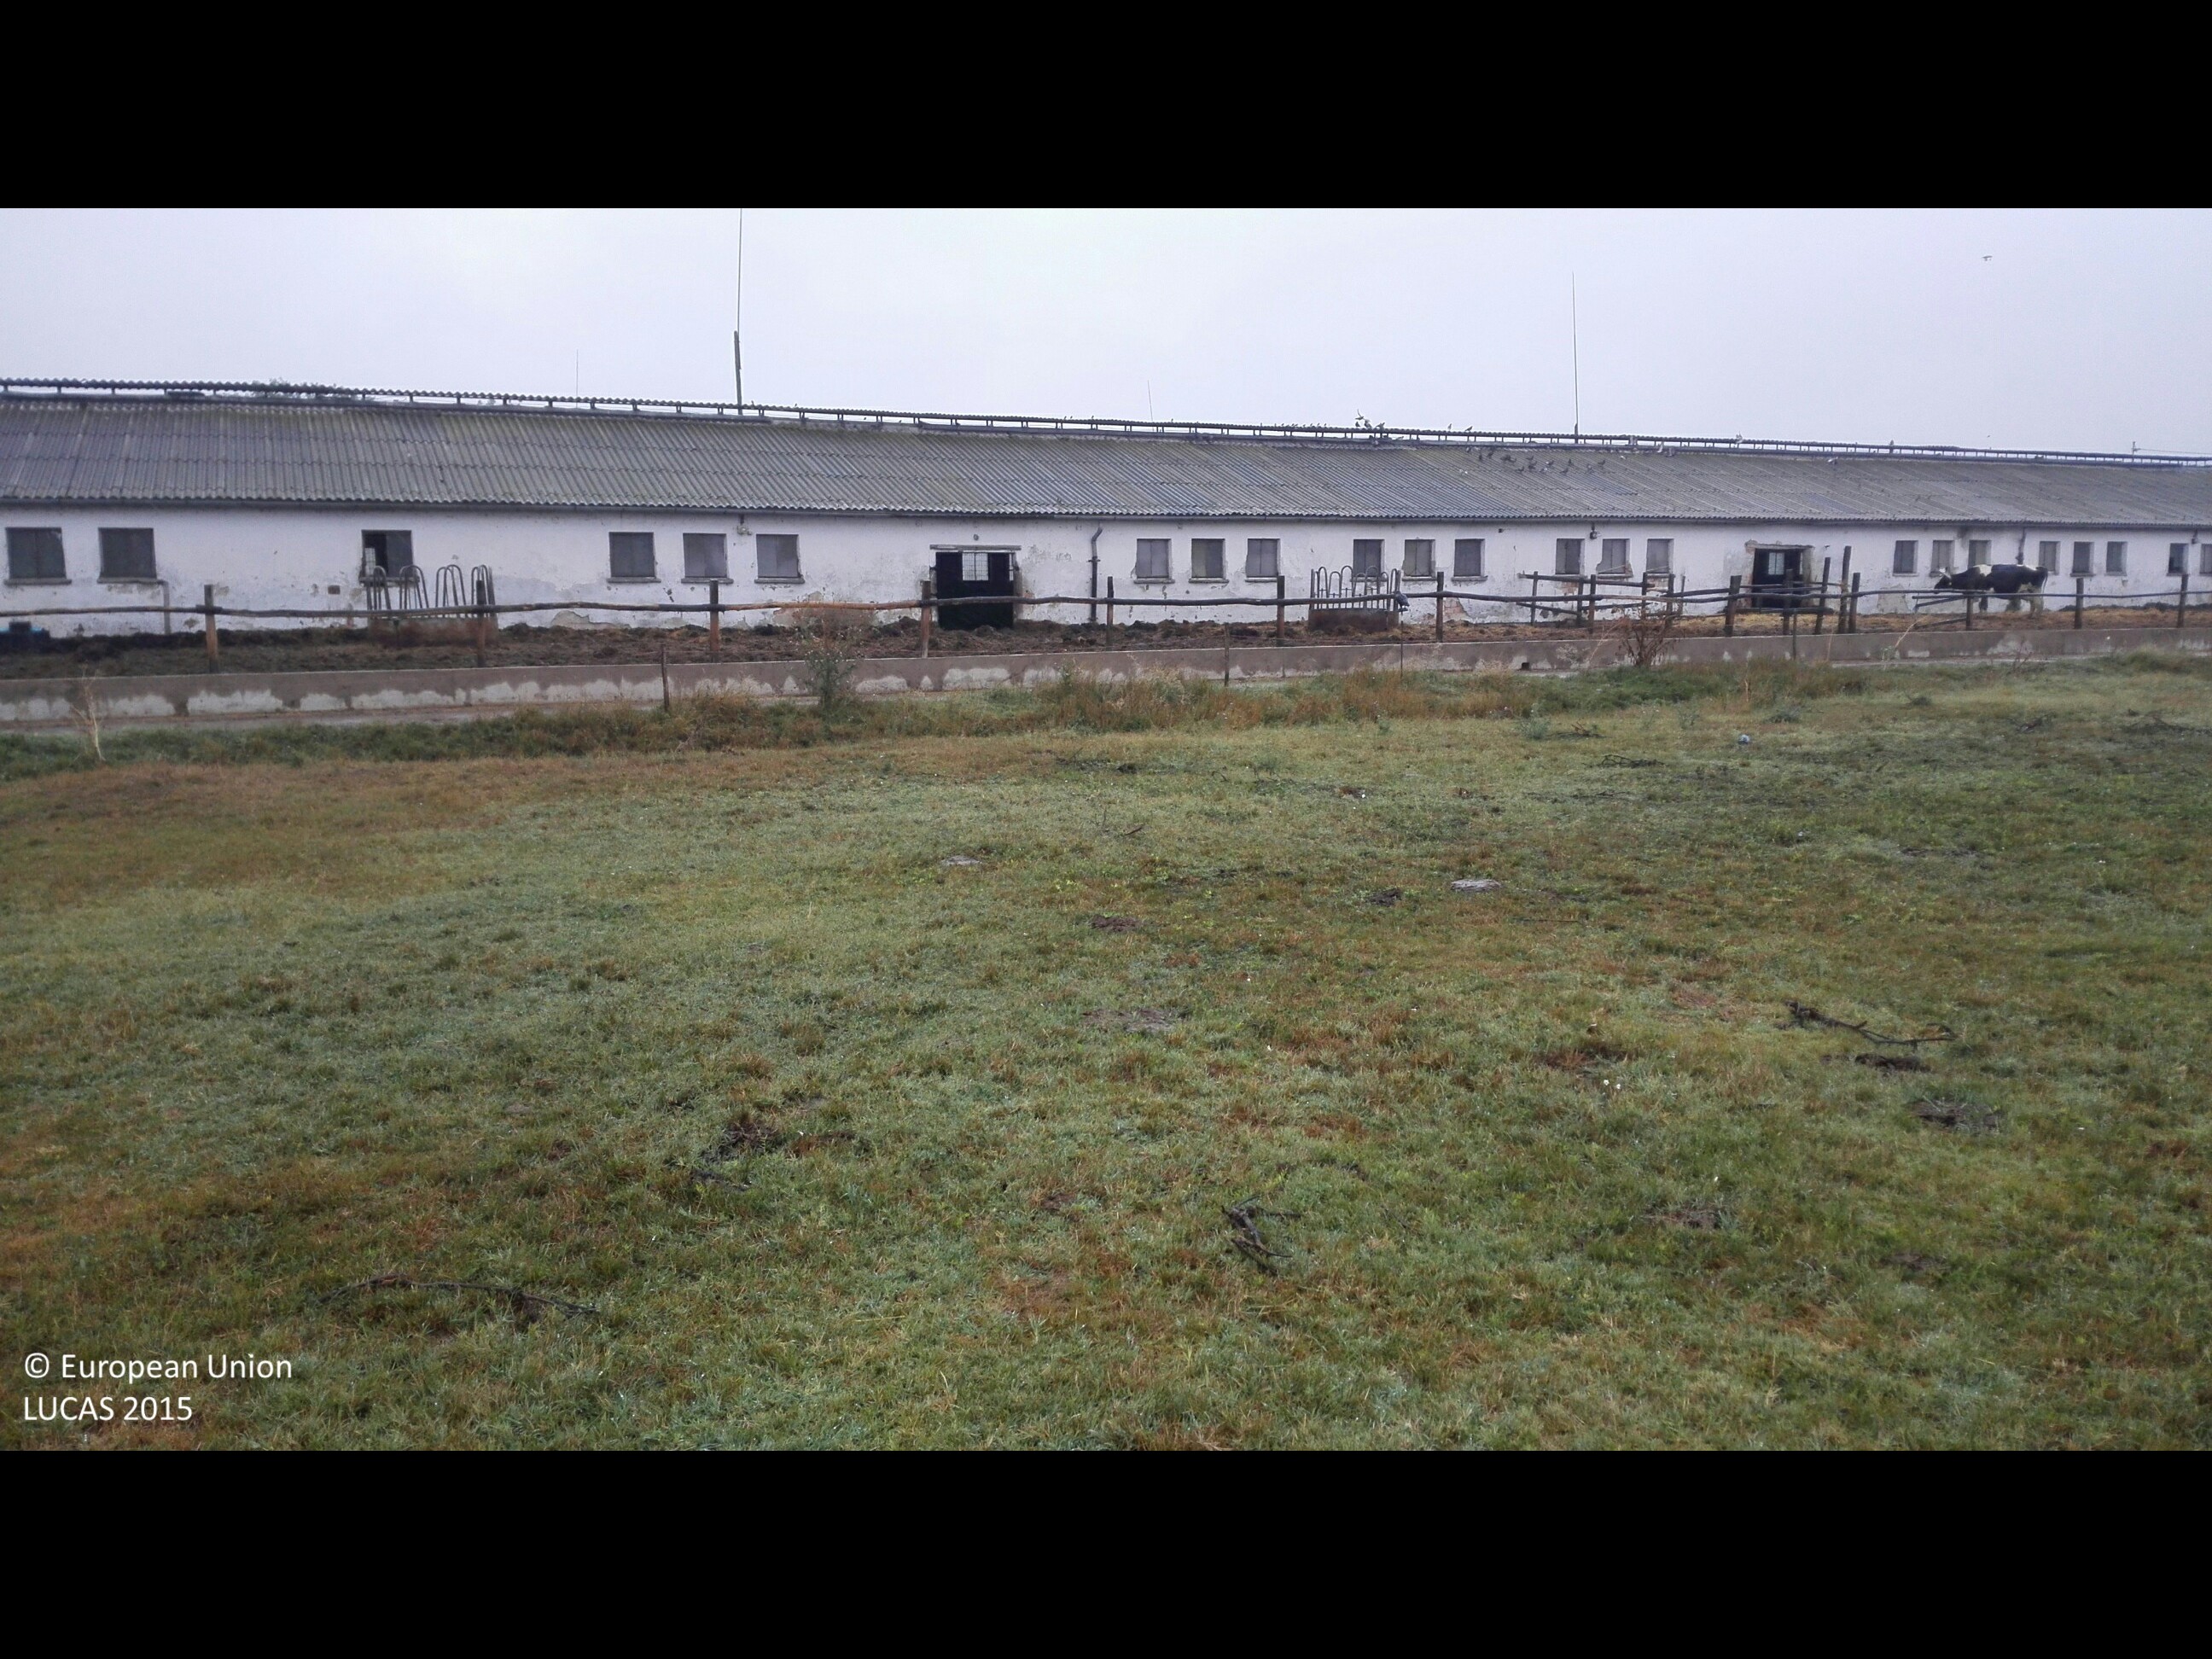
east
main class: Grassland
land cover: Grassland without tree/shrub cover
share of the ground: > 75 %
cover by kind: herbaceous plants 100 %
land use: Agriculture (excluding fallow land and kitchen gardens)
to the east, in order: Grassland without tree/shrub cover; Ditches and canals; Artificial constructions in urban areas; Grassland without tree/shrub cover; Tracks; Grassland without tree/shrub cover; Tracks; Grassland without tree/shrub cover; Shrubland with sparse tree cover; Tracks
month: August
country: HU
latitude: 47.1861
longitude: 21.6432
